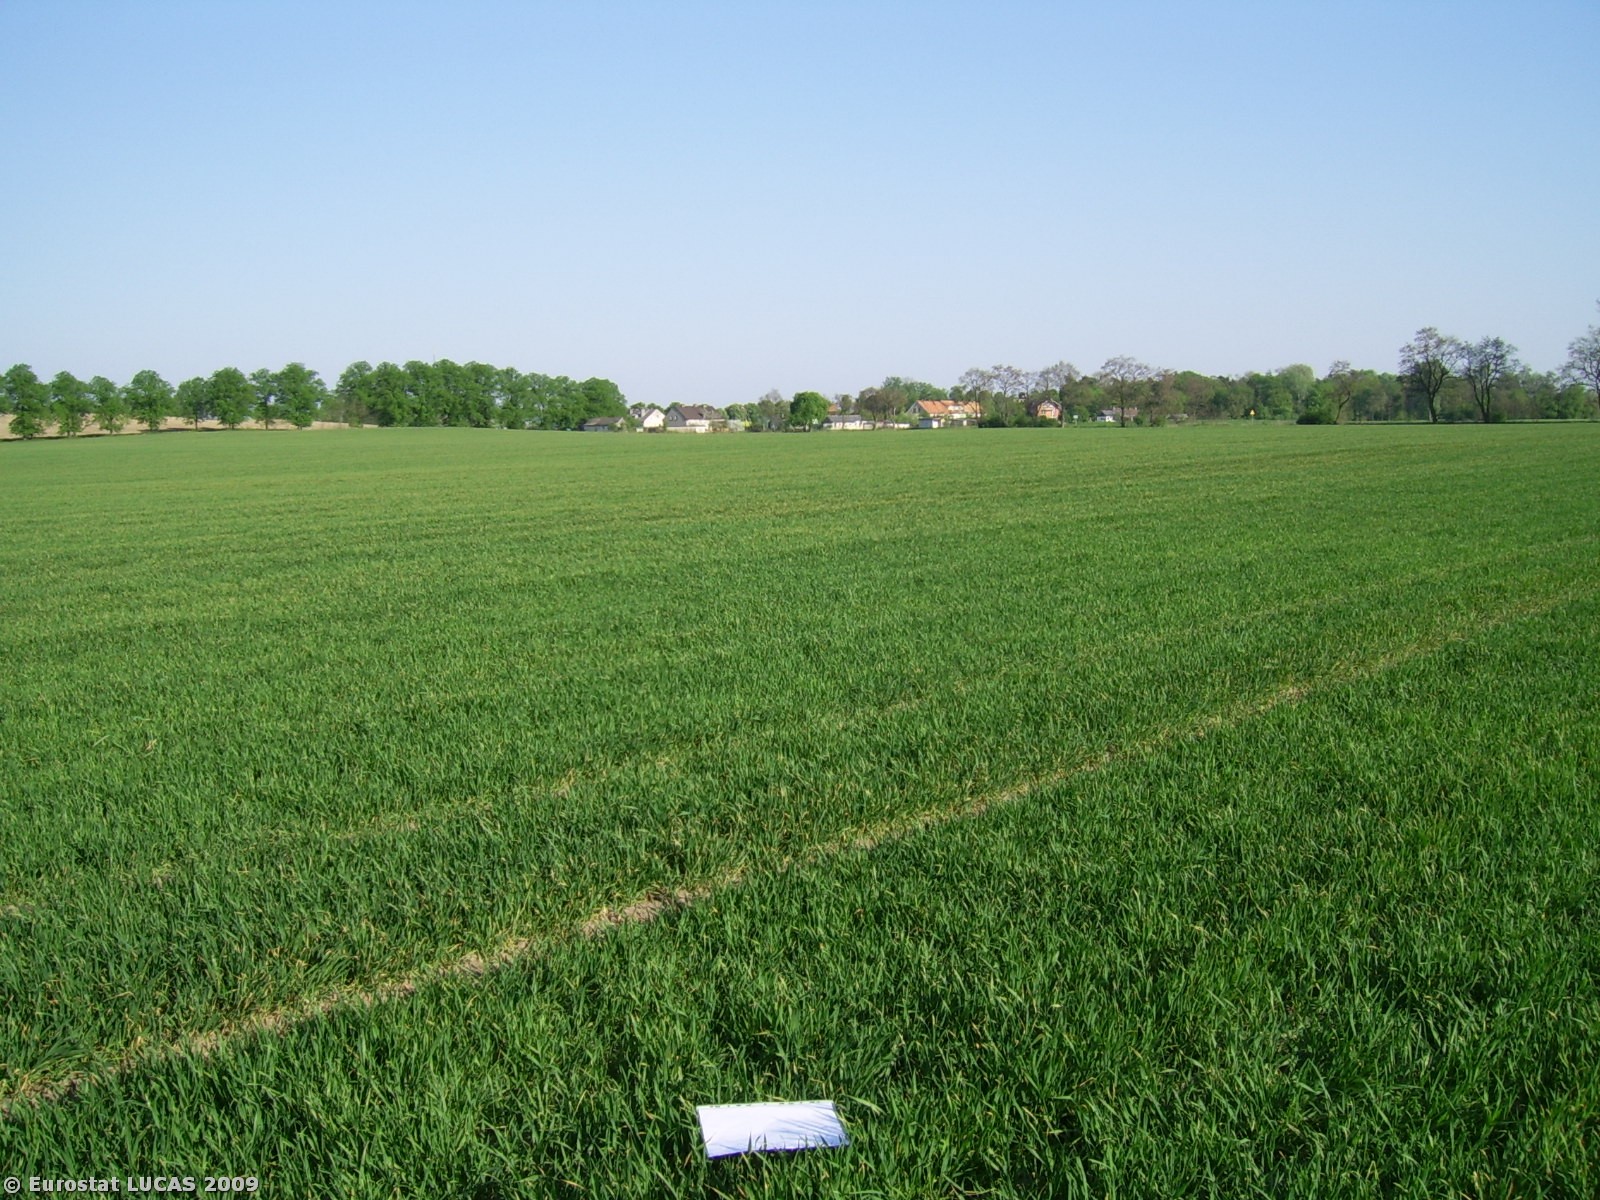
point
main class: Cropland
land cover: Common wheat
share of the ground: > 75 %
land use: Agriculture (excluding fallow land and kitchen gardens)
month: April
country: PL
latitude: 52.1394
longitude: 16.9207
